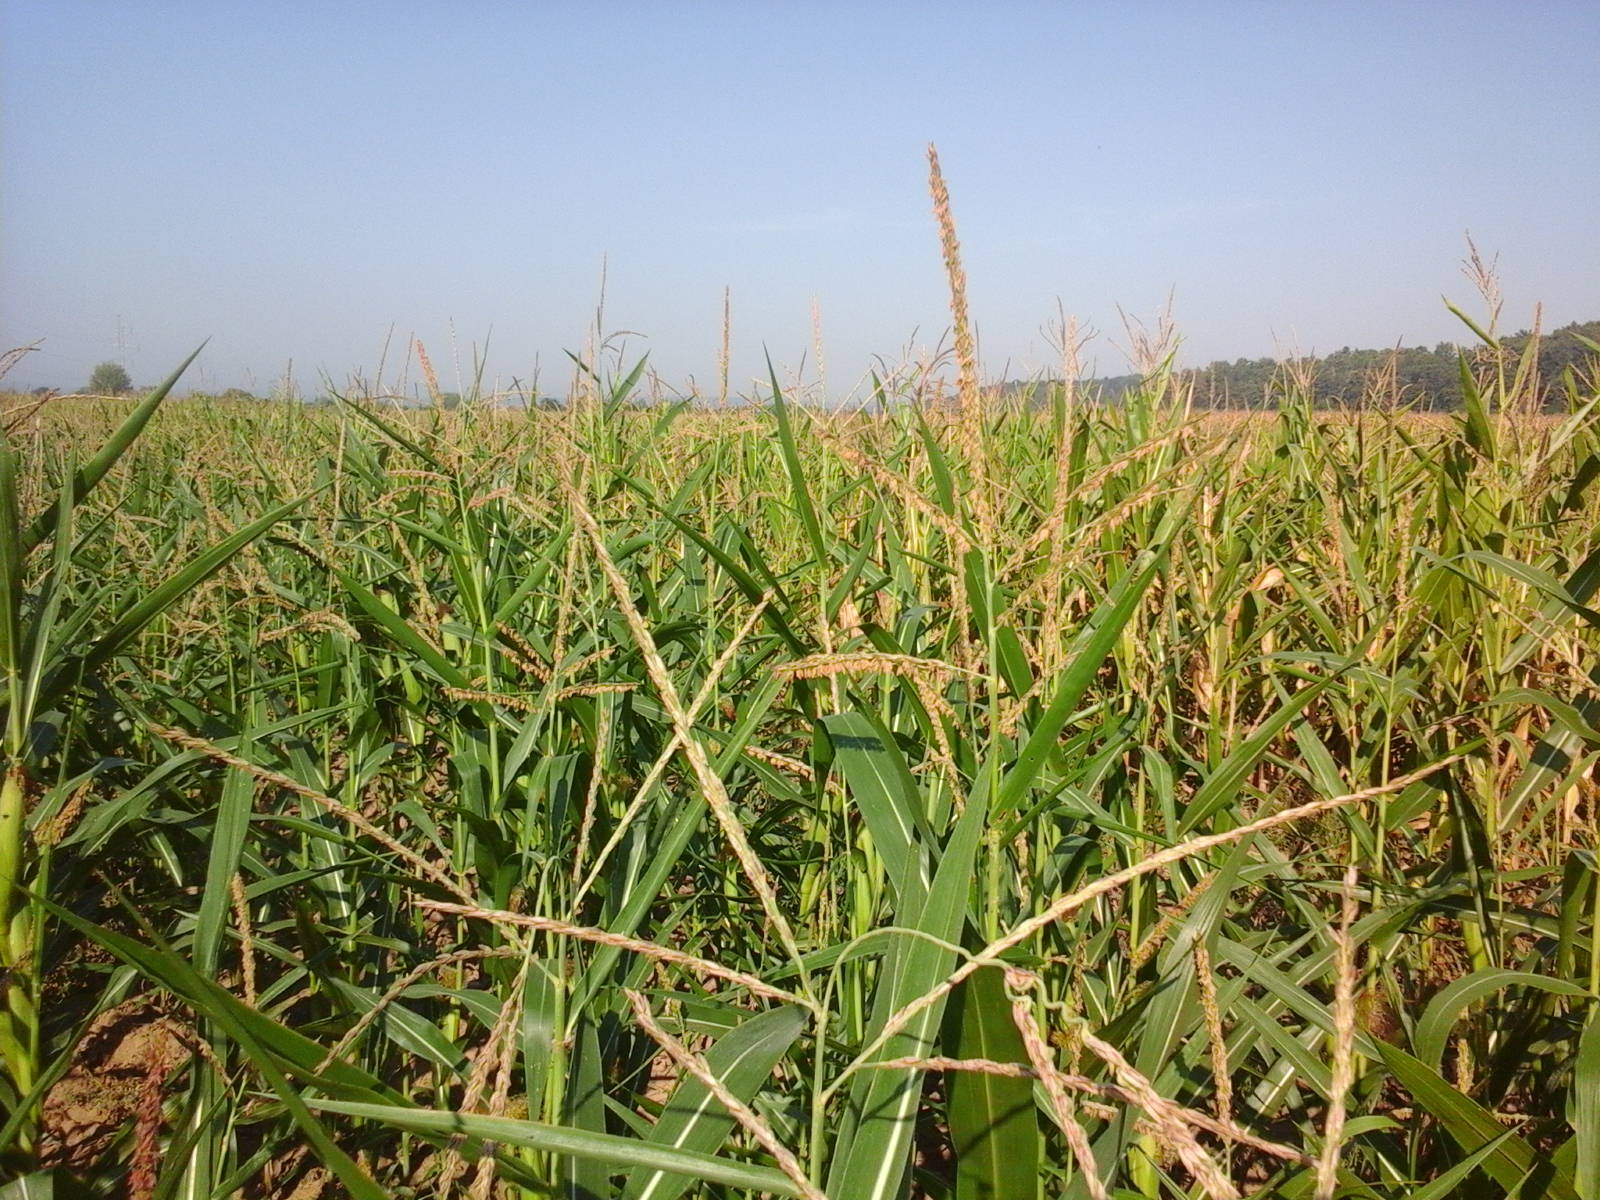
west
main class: Cropland
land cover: Maize
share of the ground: > 75 %
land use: Agriculture (excluding fallow land and kitchen gardens)
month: August
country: RO
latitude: 46.0202
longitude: 22.1470
